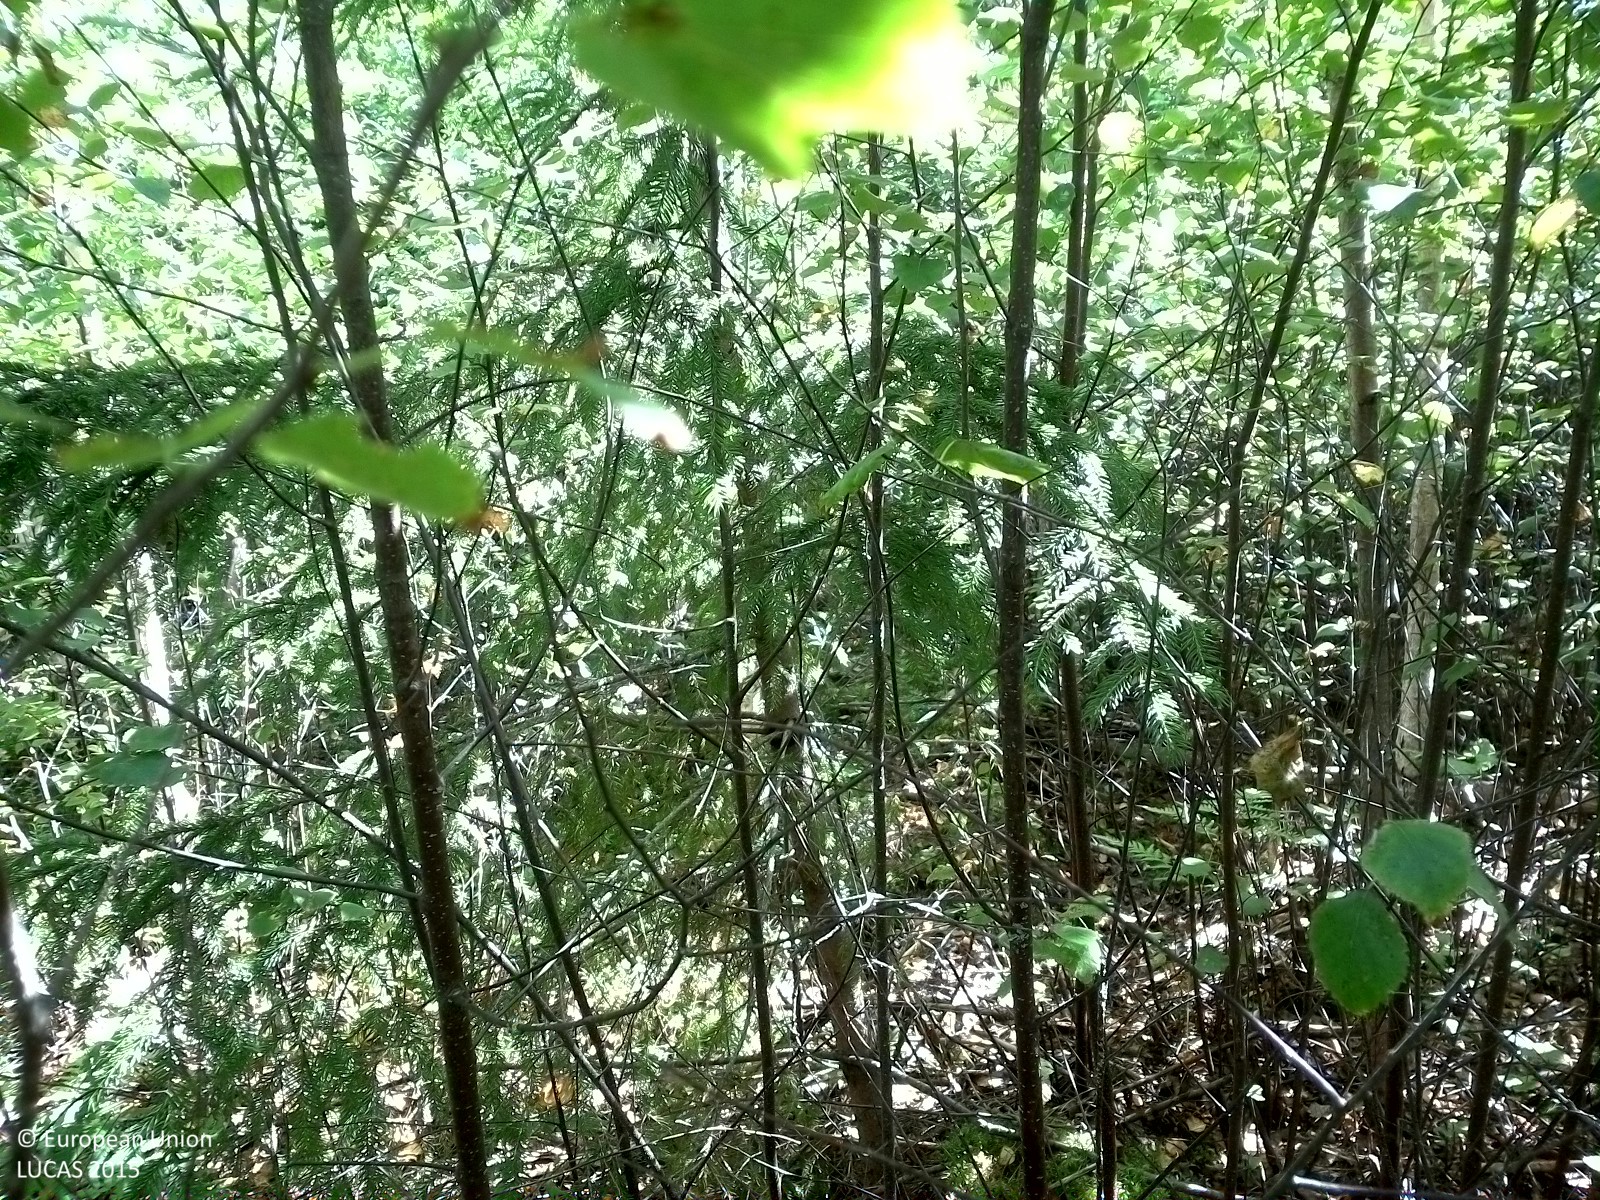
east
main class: Woodland
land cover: Broadleaved woodland
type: hemiboreal forest and nemoral coniferous forest and mixed broadleaved-coniferous forest
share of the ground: > 75 %
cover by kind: broadleaved forest trees 90 %, herbaceous plants 5 %, unconsolidated bare surface 5 %
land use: Forestry
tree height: < 5 m
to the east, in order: Broadleaved woodland; Spruce dominated mixed woodland; Spruce dominated coniferous woodland; Spruce dominated mixed woodland
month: August
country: SE
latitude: 59.2469
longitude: 15.4096
